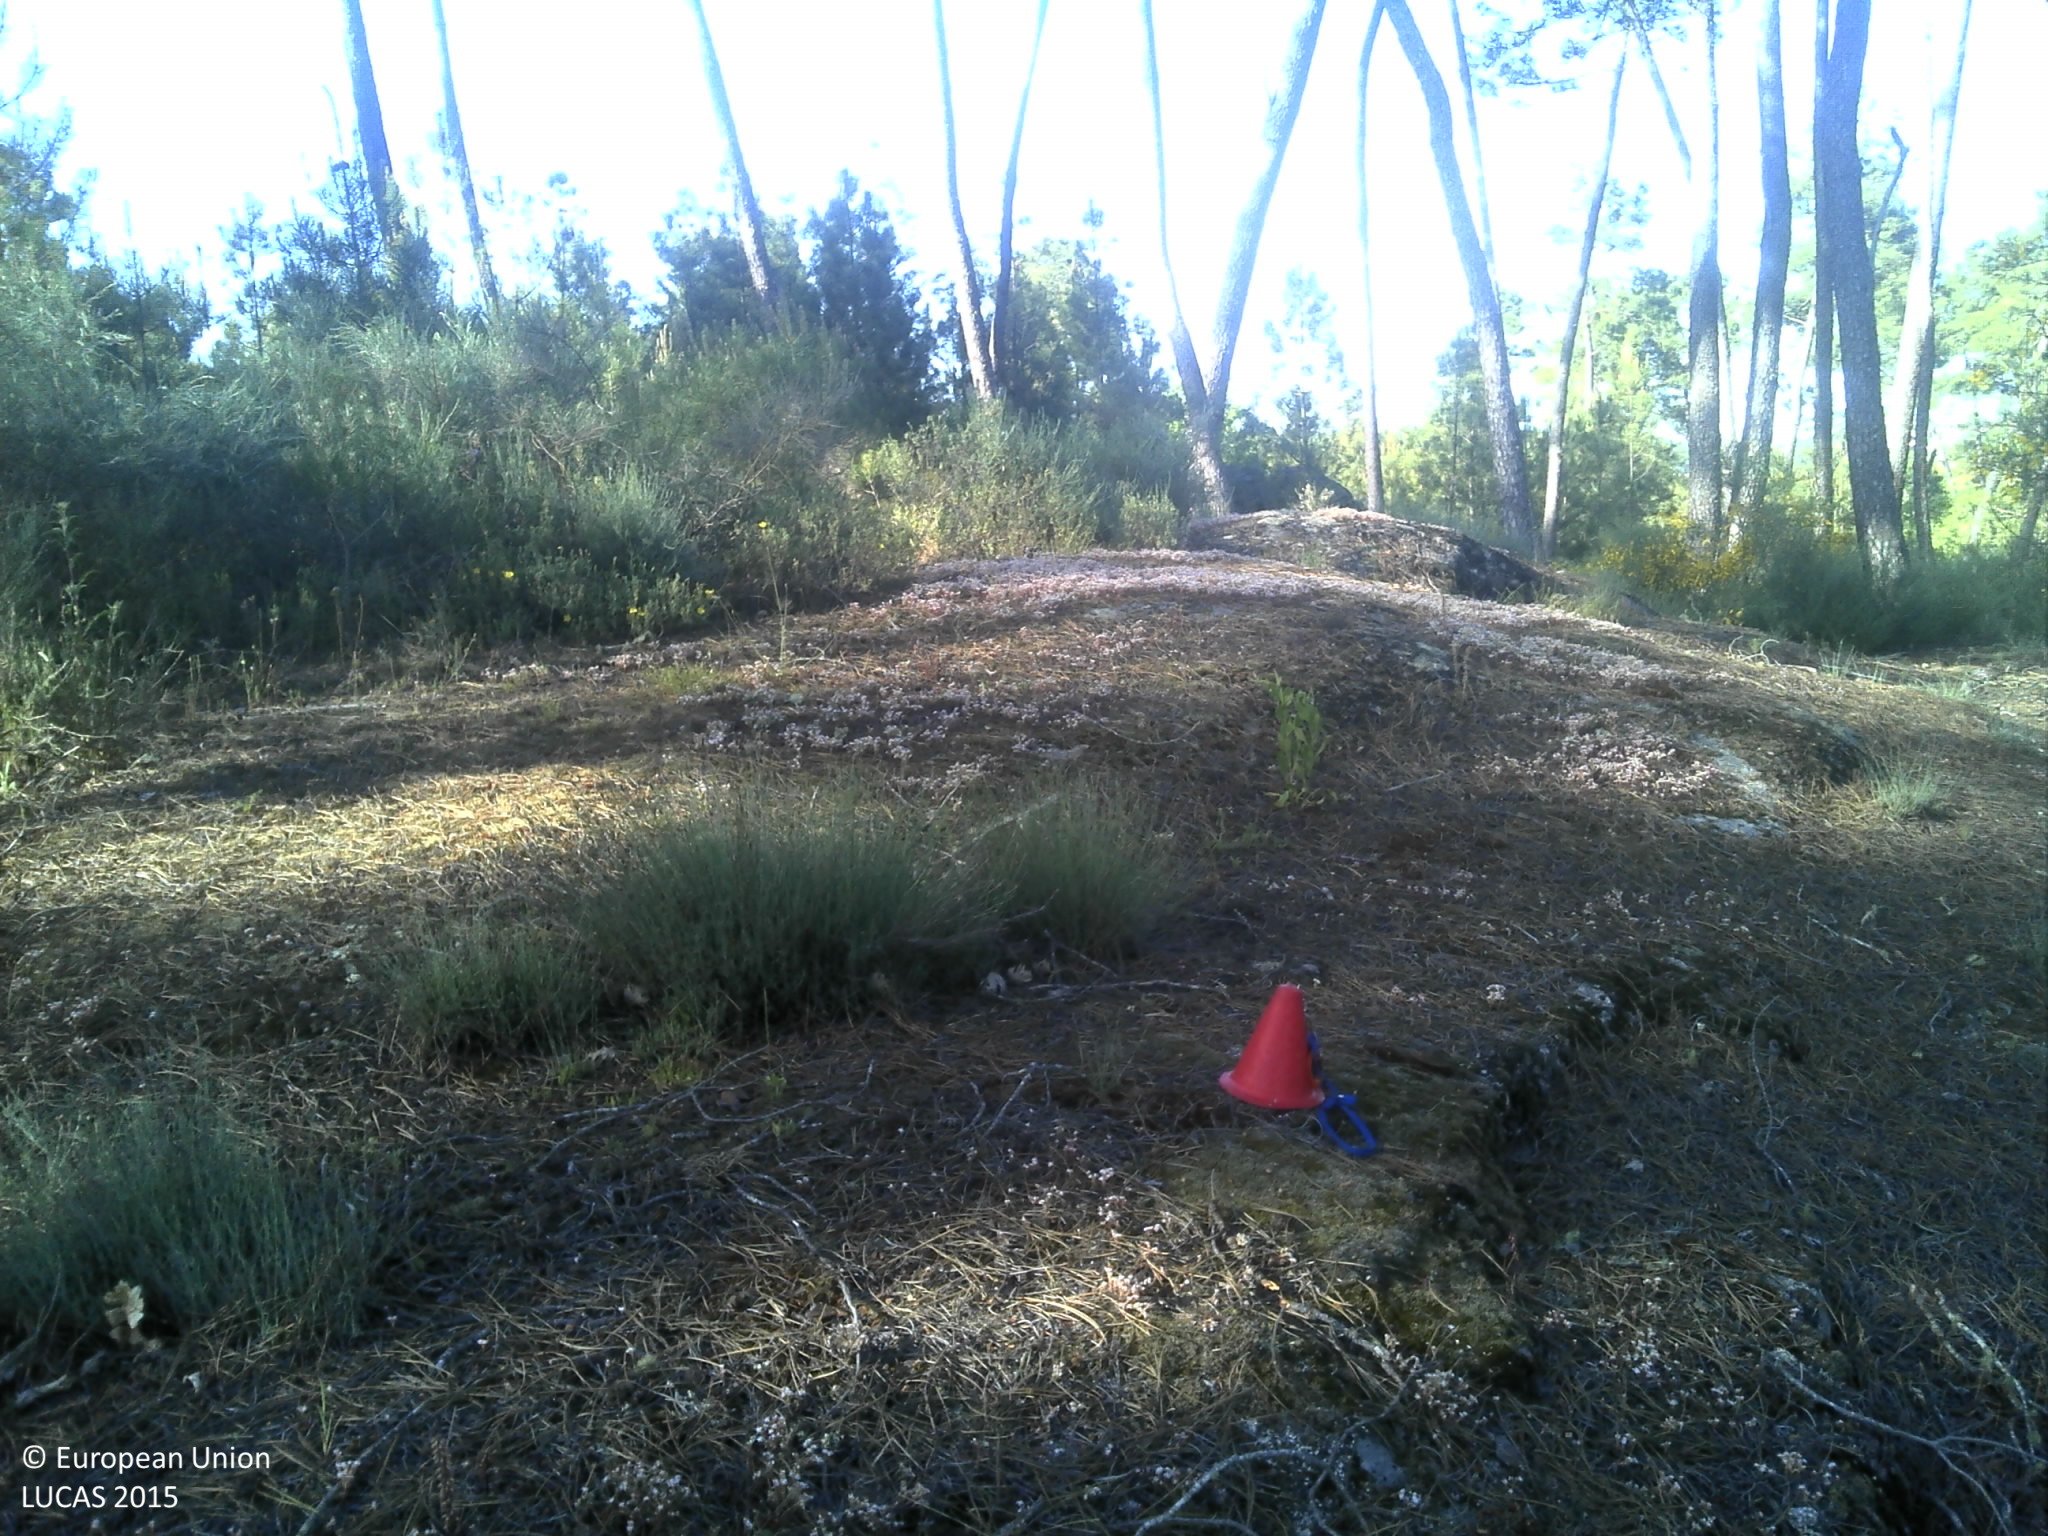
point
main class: Woodland
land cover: Pine dominated coniferous woodland
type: coniferous forest of the mediterranean region
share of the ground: 25 - 50 %
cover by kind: coniferous forest trees 60 %, shrubs 10 %, herbaceous plants 10 %, unconsolidated bare surface 10 %
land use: Forestry
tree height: > 5 m
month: May
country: PT
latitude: 40.7245
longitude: -7.2155
